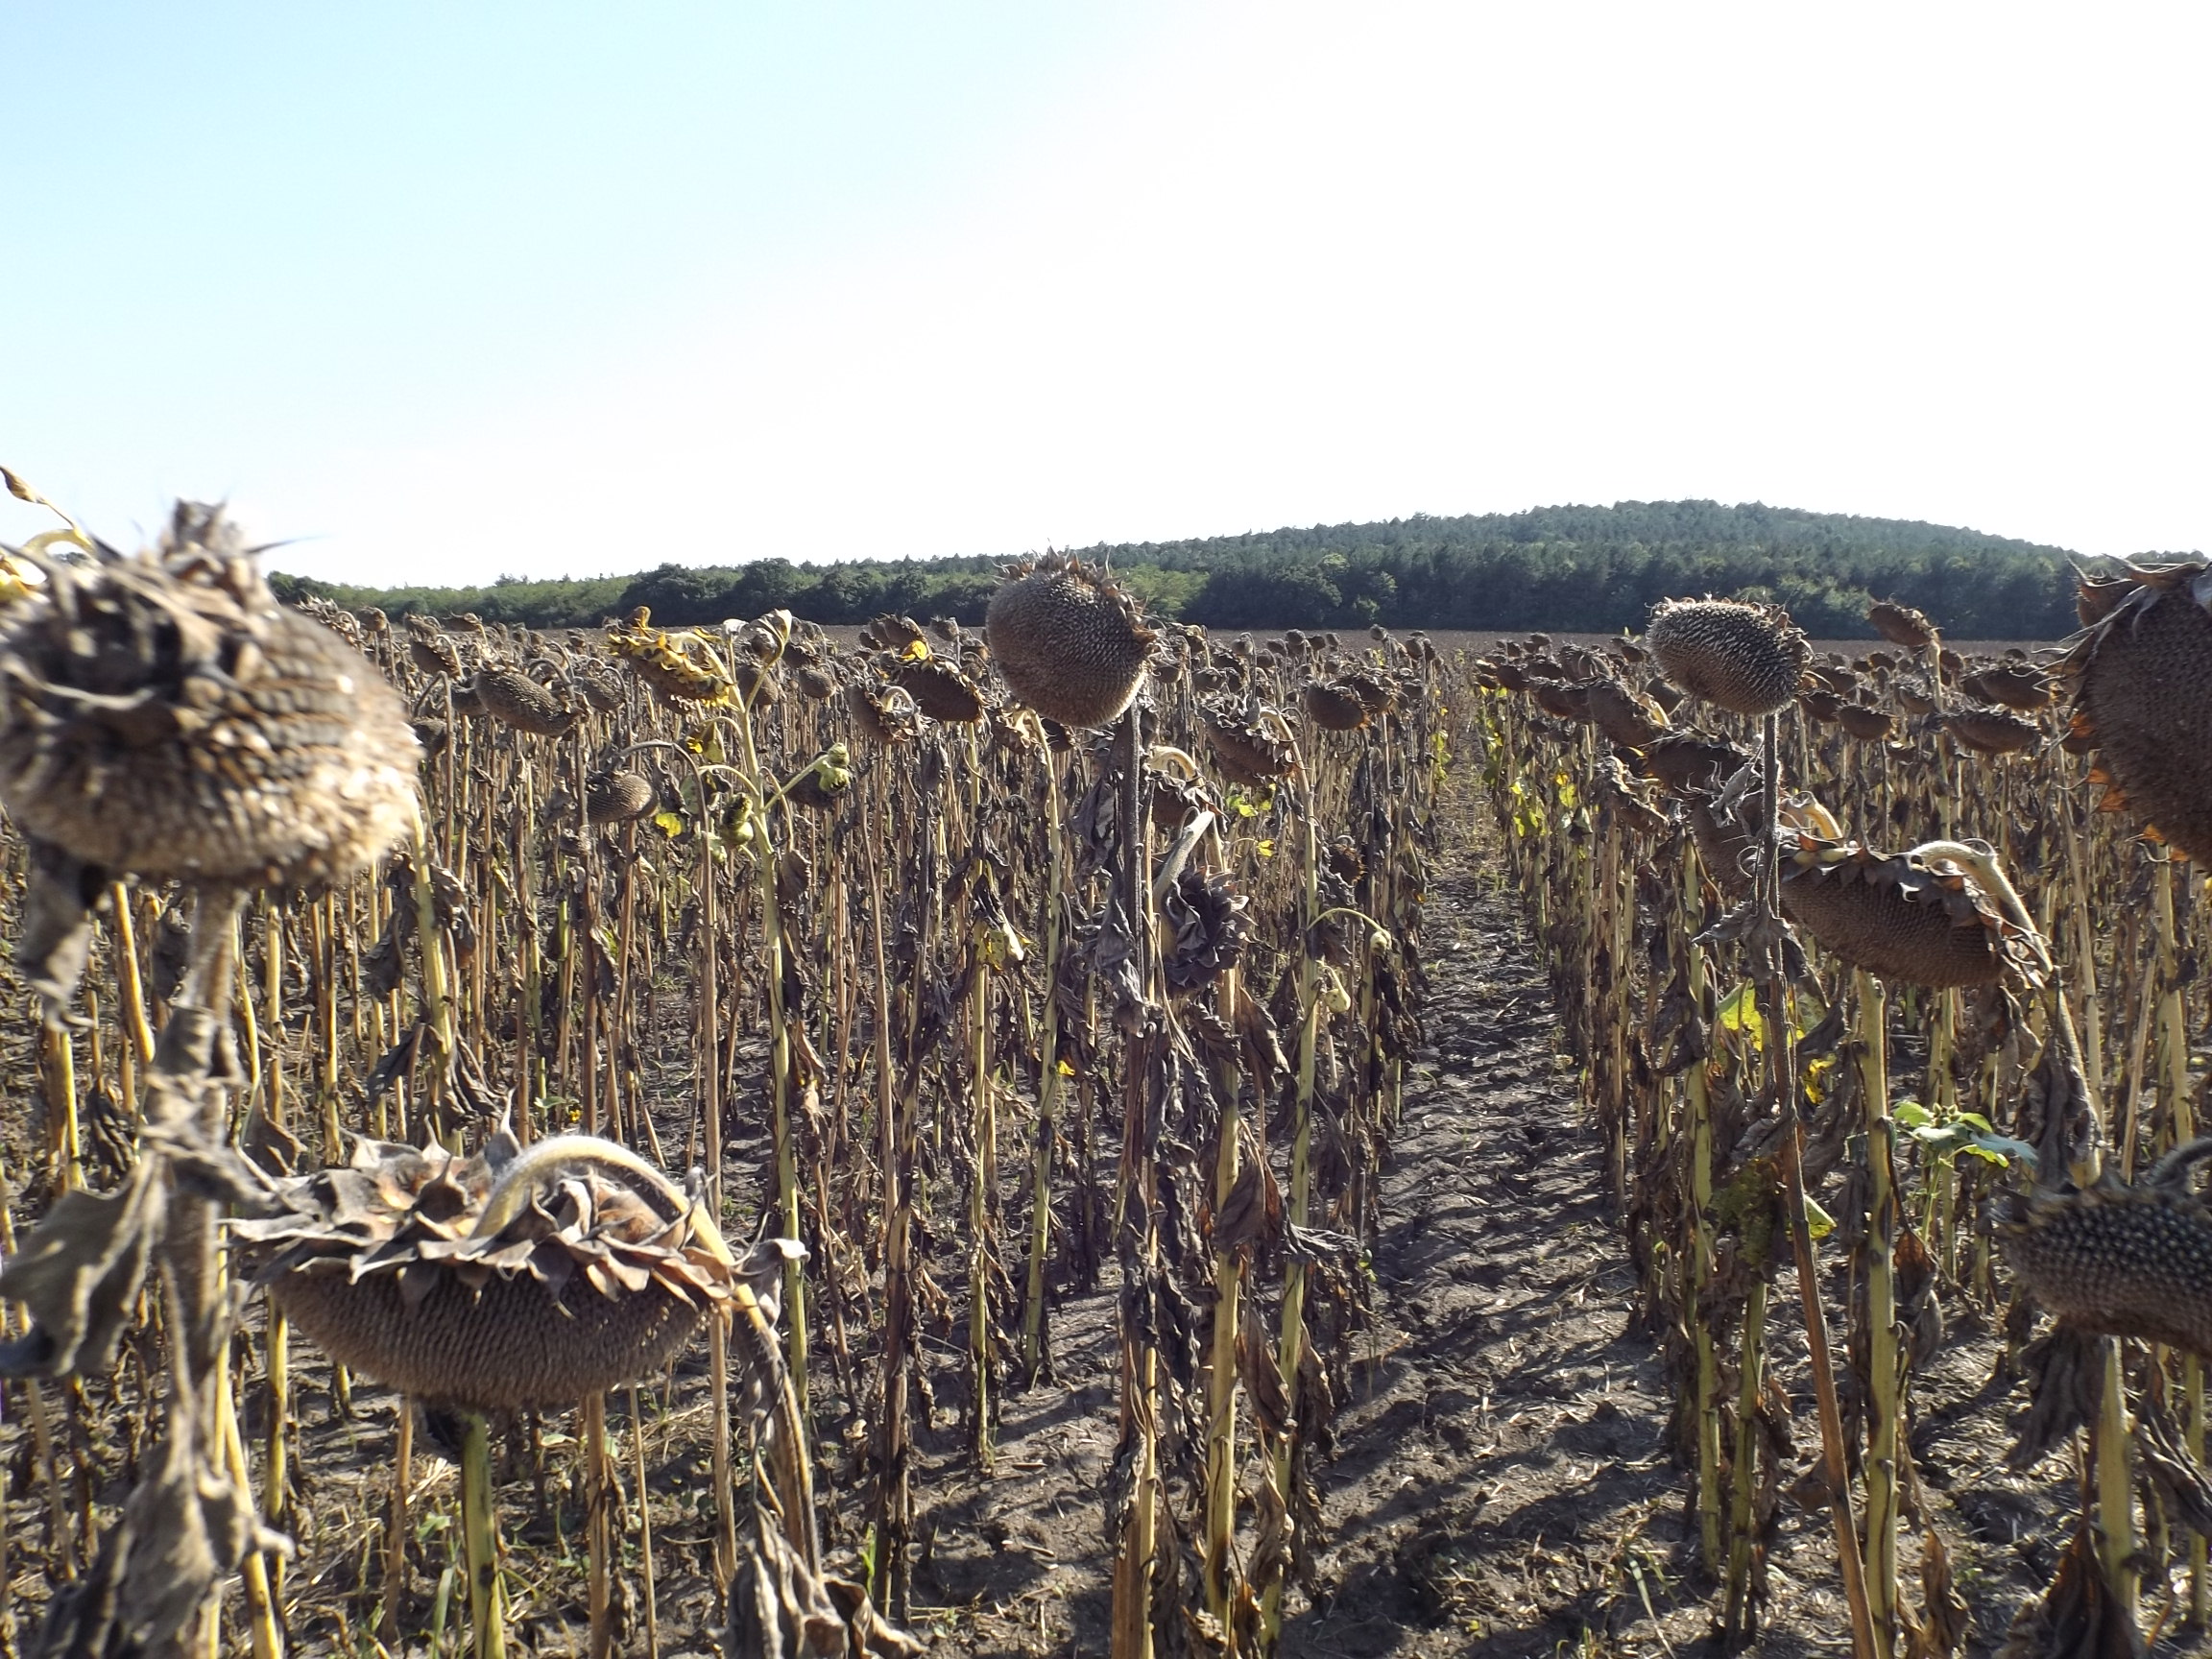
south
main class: Cropland
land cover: Sunflower
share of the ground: > 75 %
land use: Agriculture (excluding fallow land and kitchen gardens)
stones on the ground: < 10 %
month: August
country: BG
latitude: 43.1040
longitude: 27.4120
